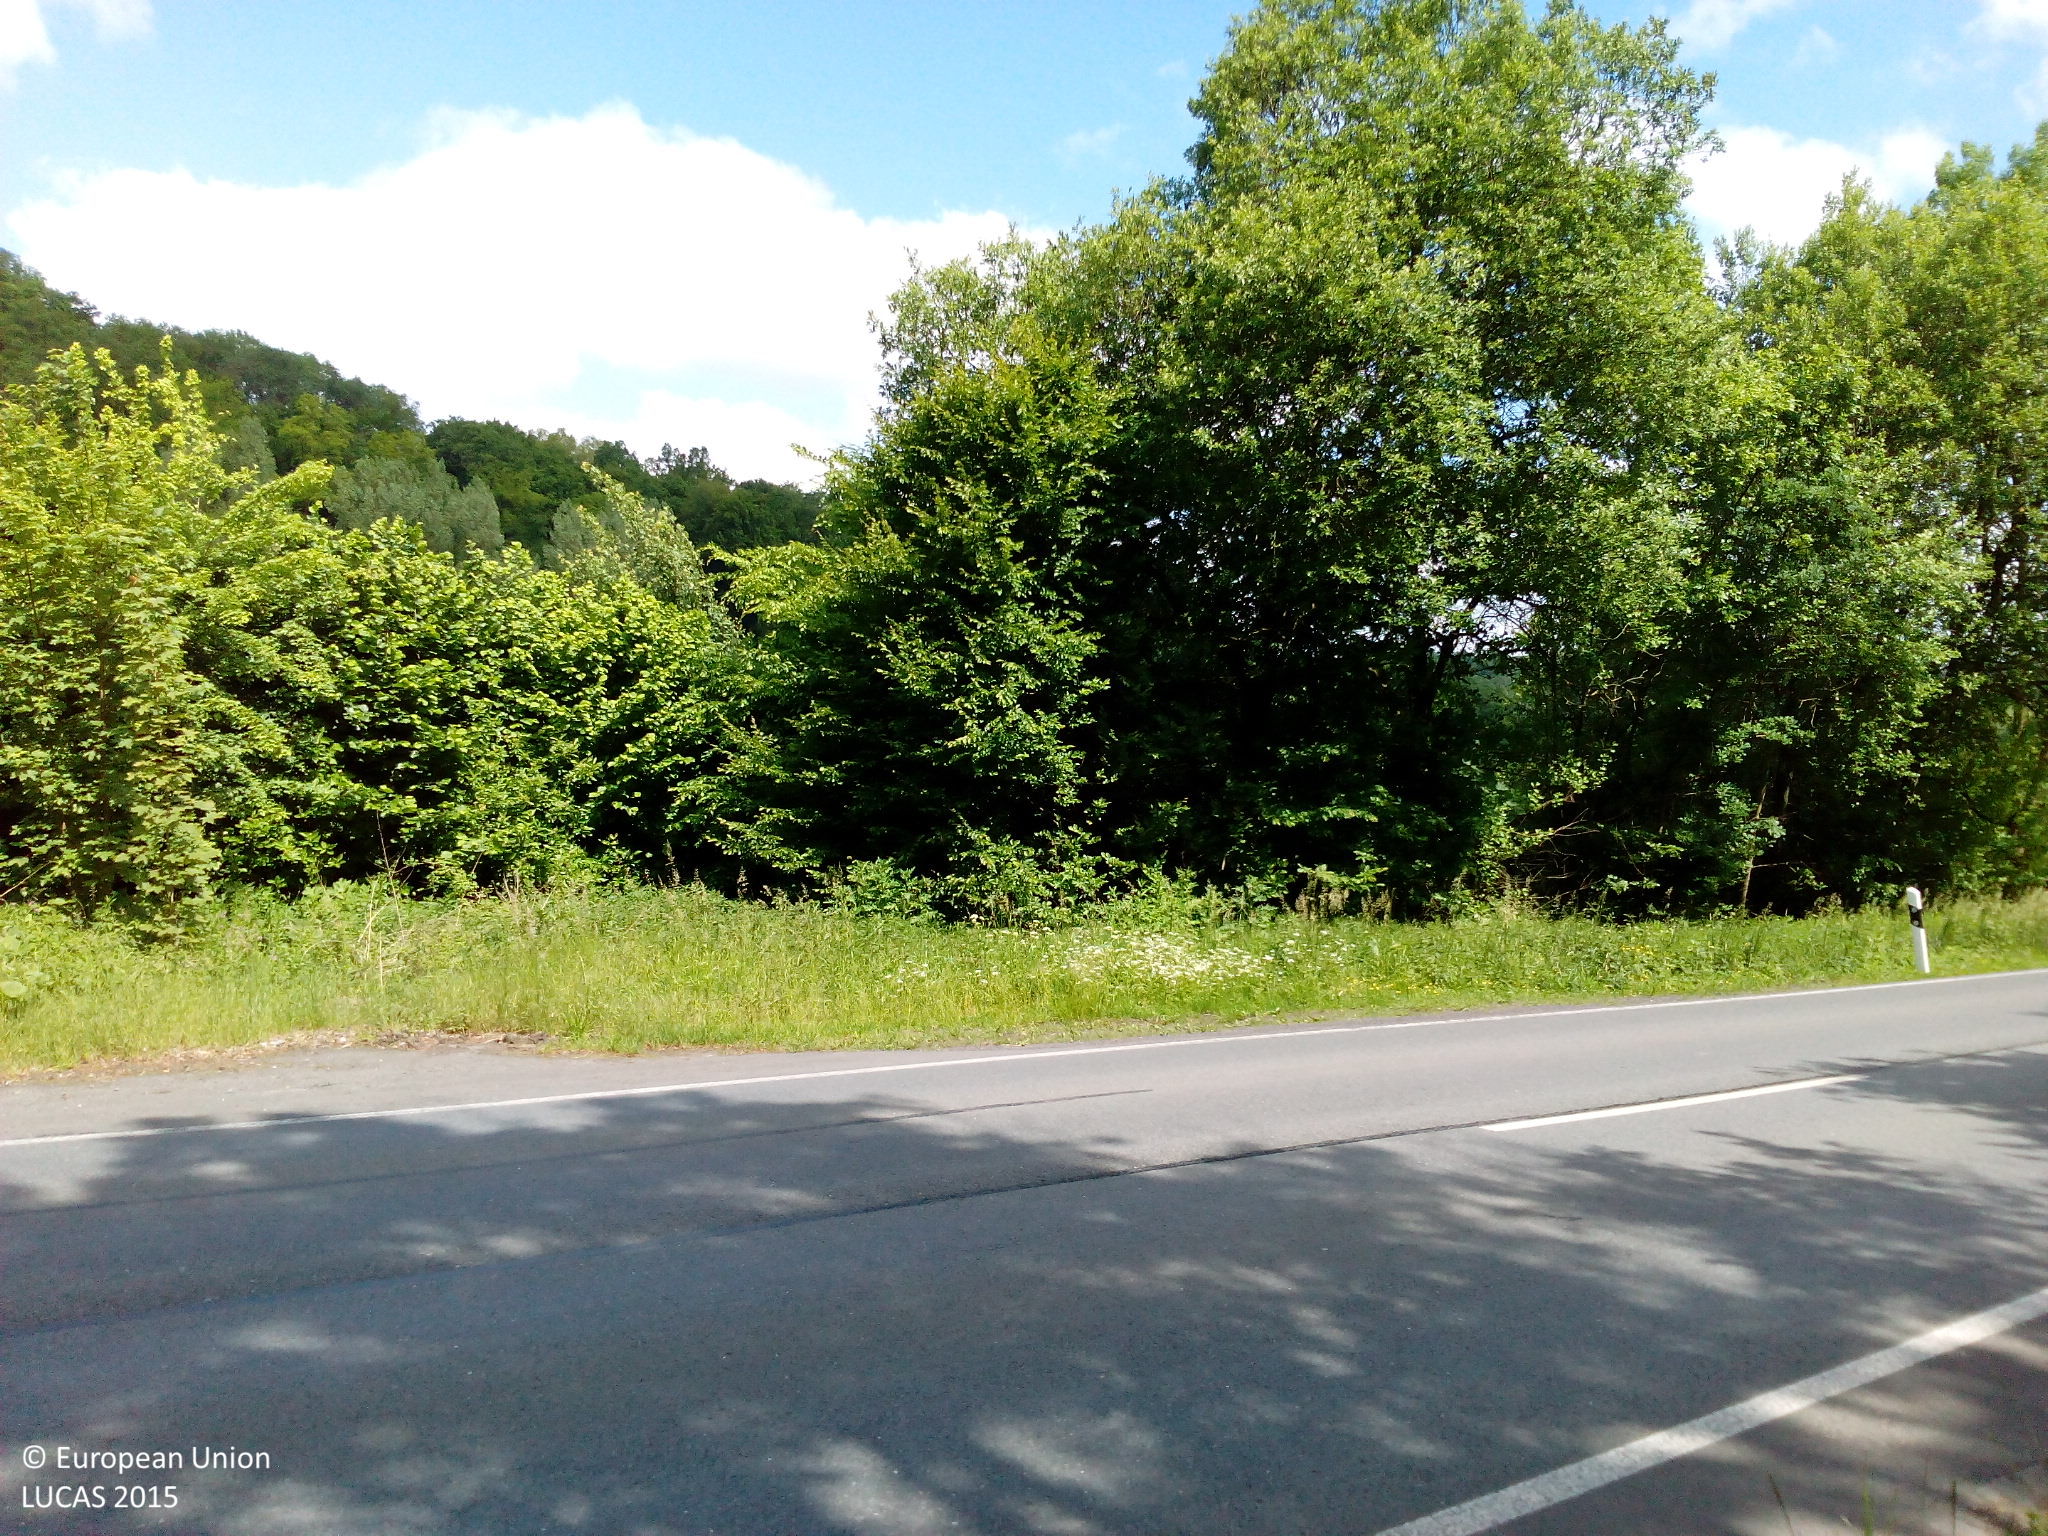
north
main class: Woodland
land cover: Broadleaved woodland
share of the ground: > 75 %
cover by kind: broadleaved forest trees 100 %
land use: Semi-natural and natural areas not in use
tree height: > 5 m
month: June
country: DE
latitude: 51.3897
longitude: 8.0028
